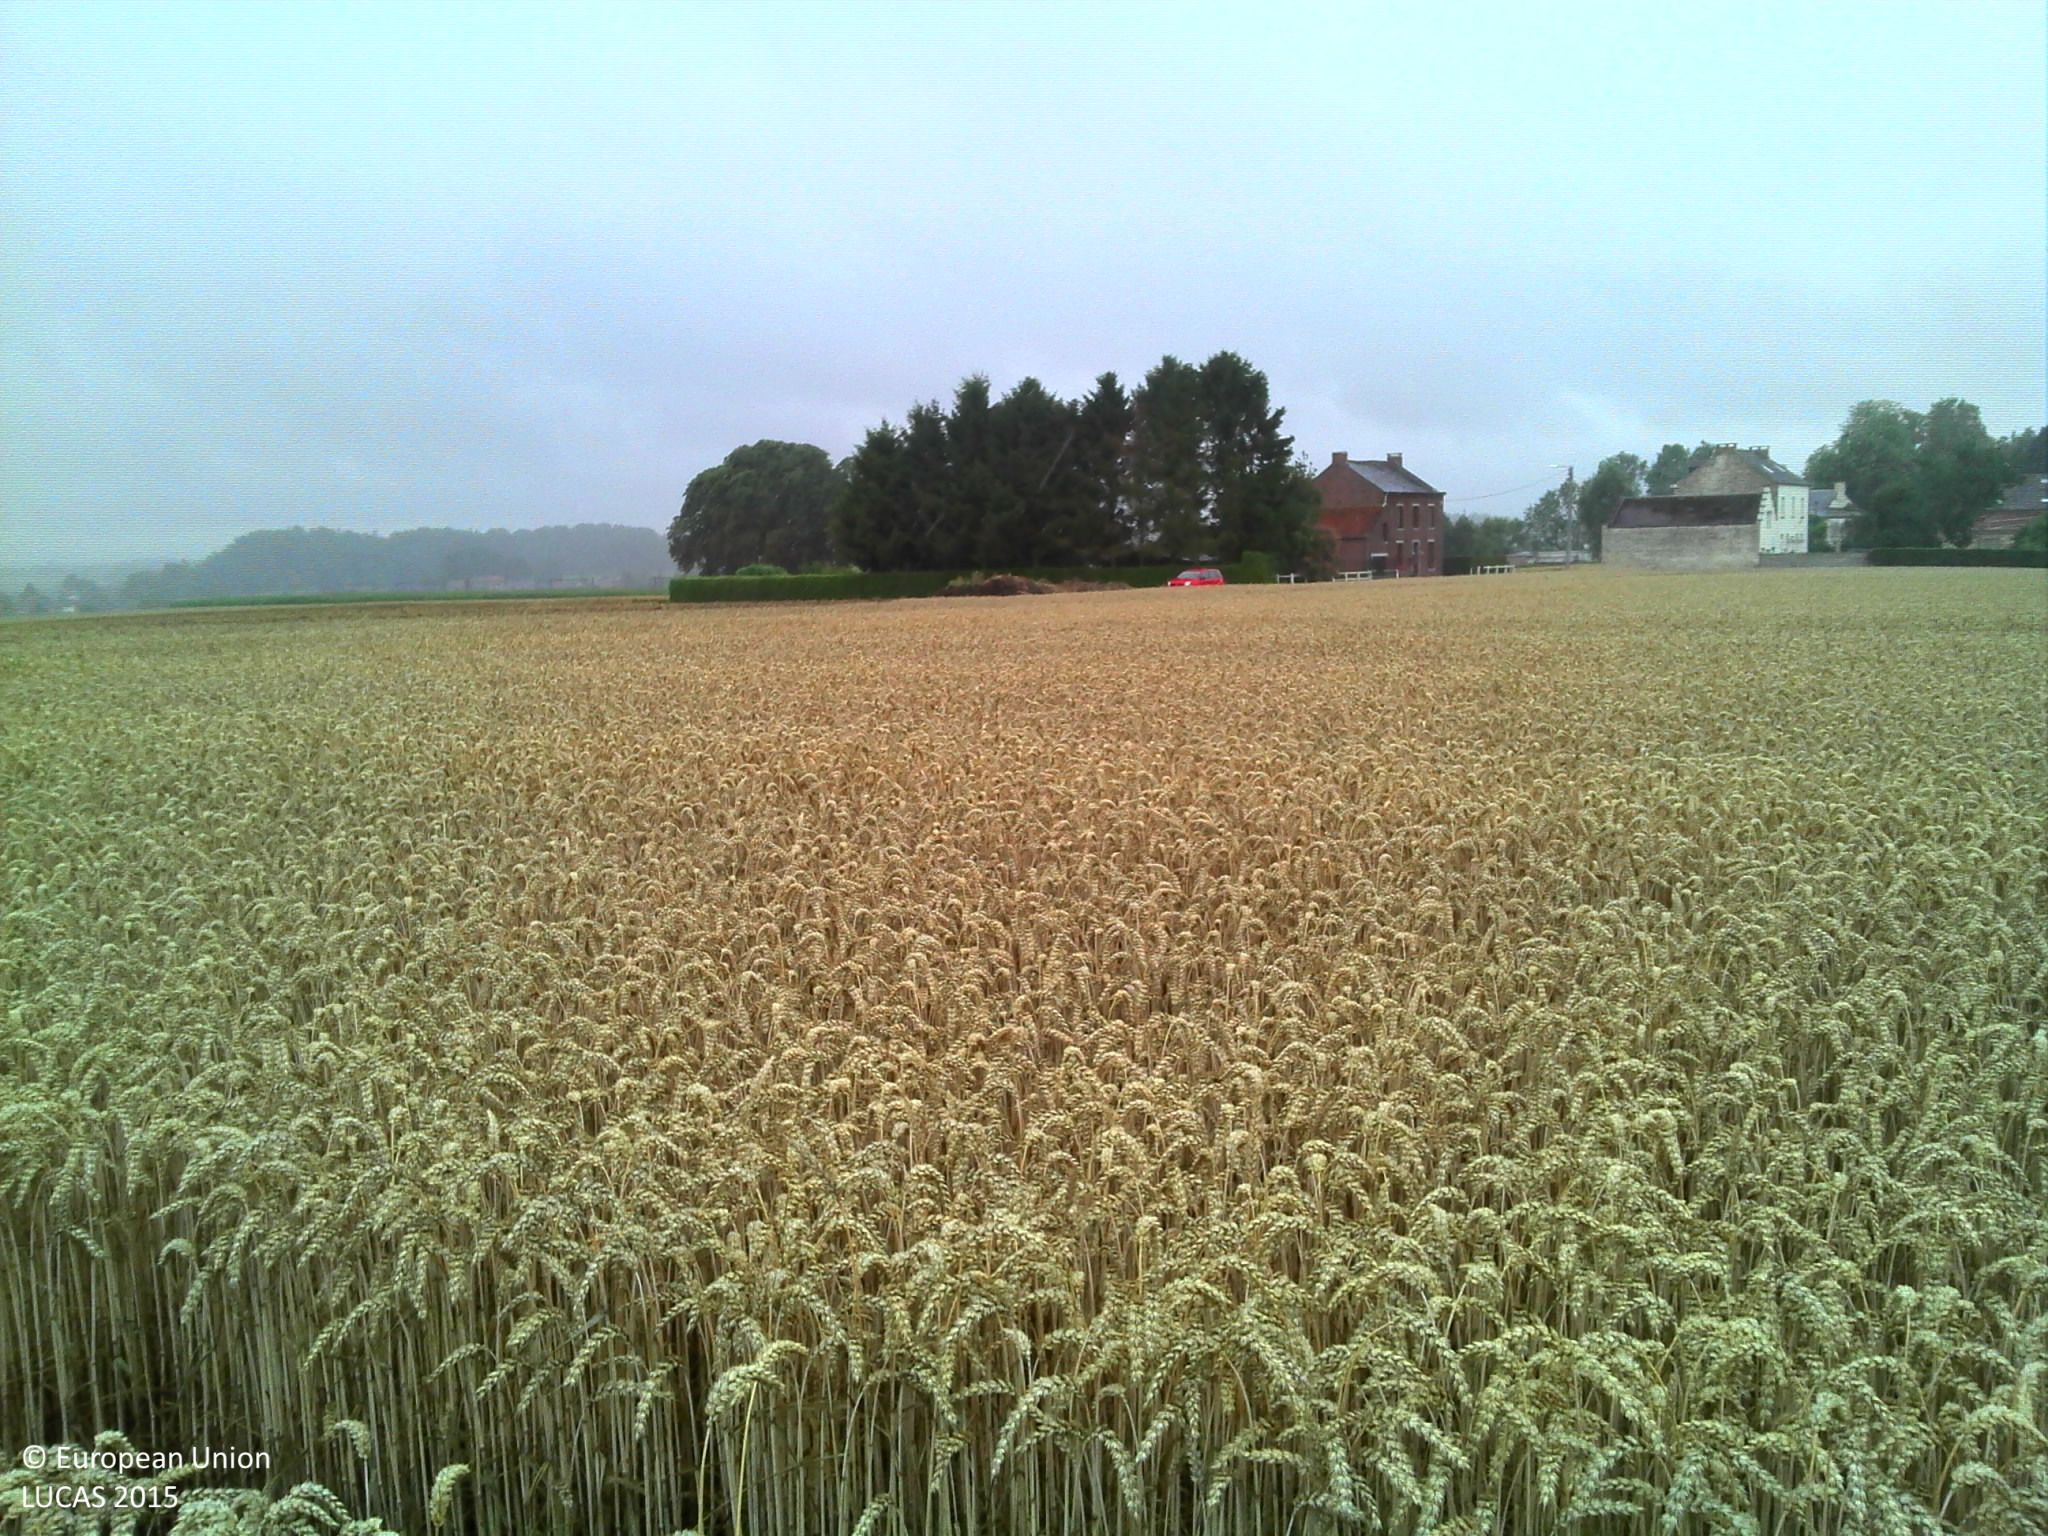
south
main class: Cropland
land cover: Common wheat
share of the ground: > 75 %
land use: Agriculture (excluding fallow land and kitchen gardens)
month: July
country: BE
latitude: 50.5233
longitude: 4.5655
